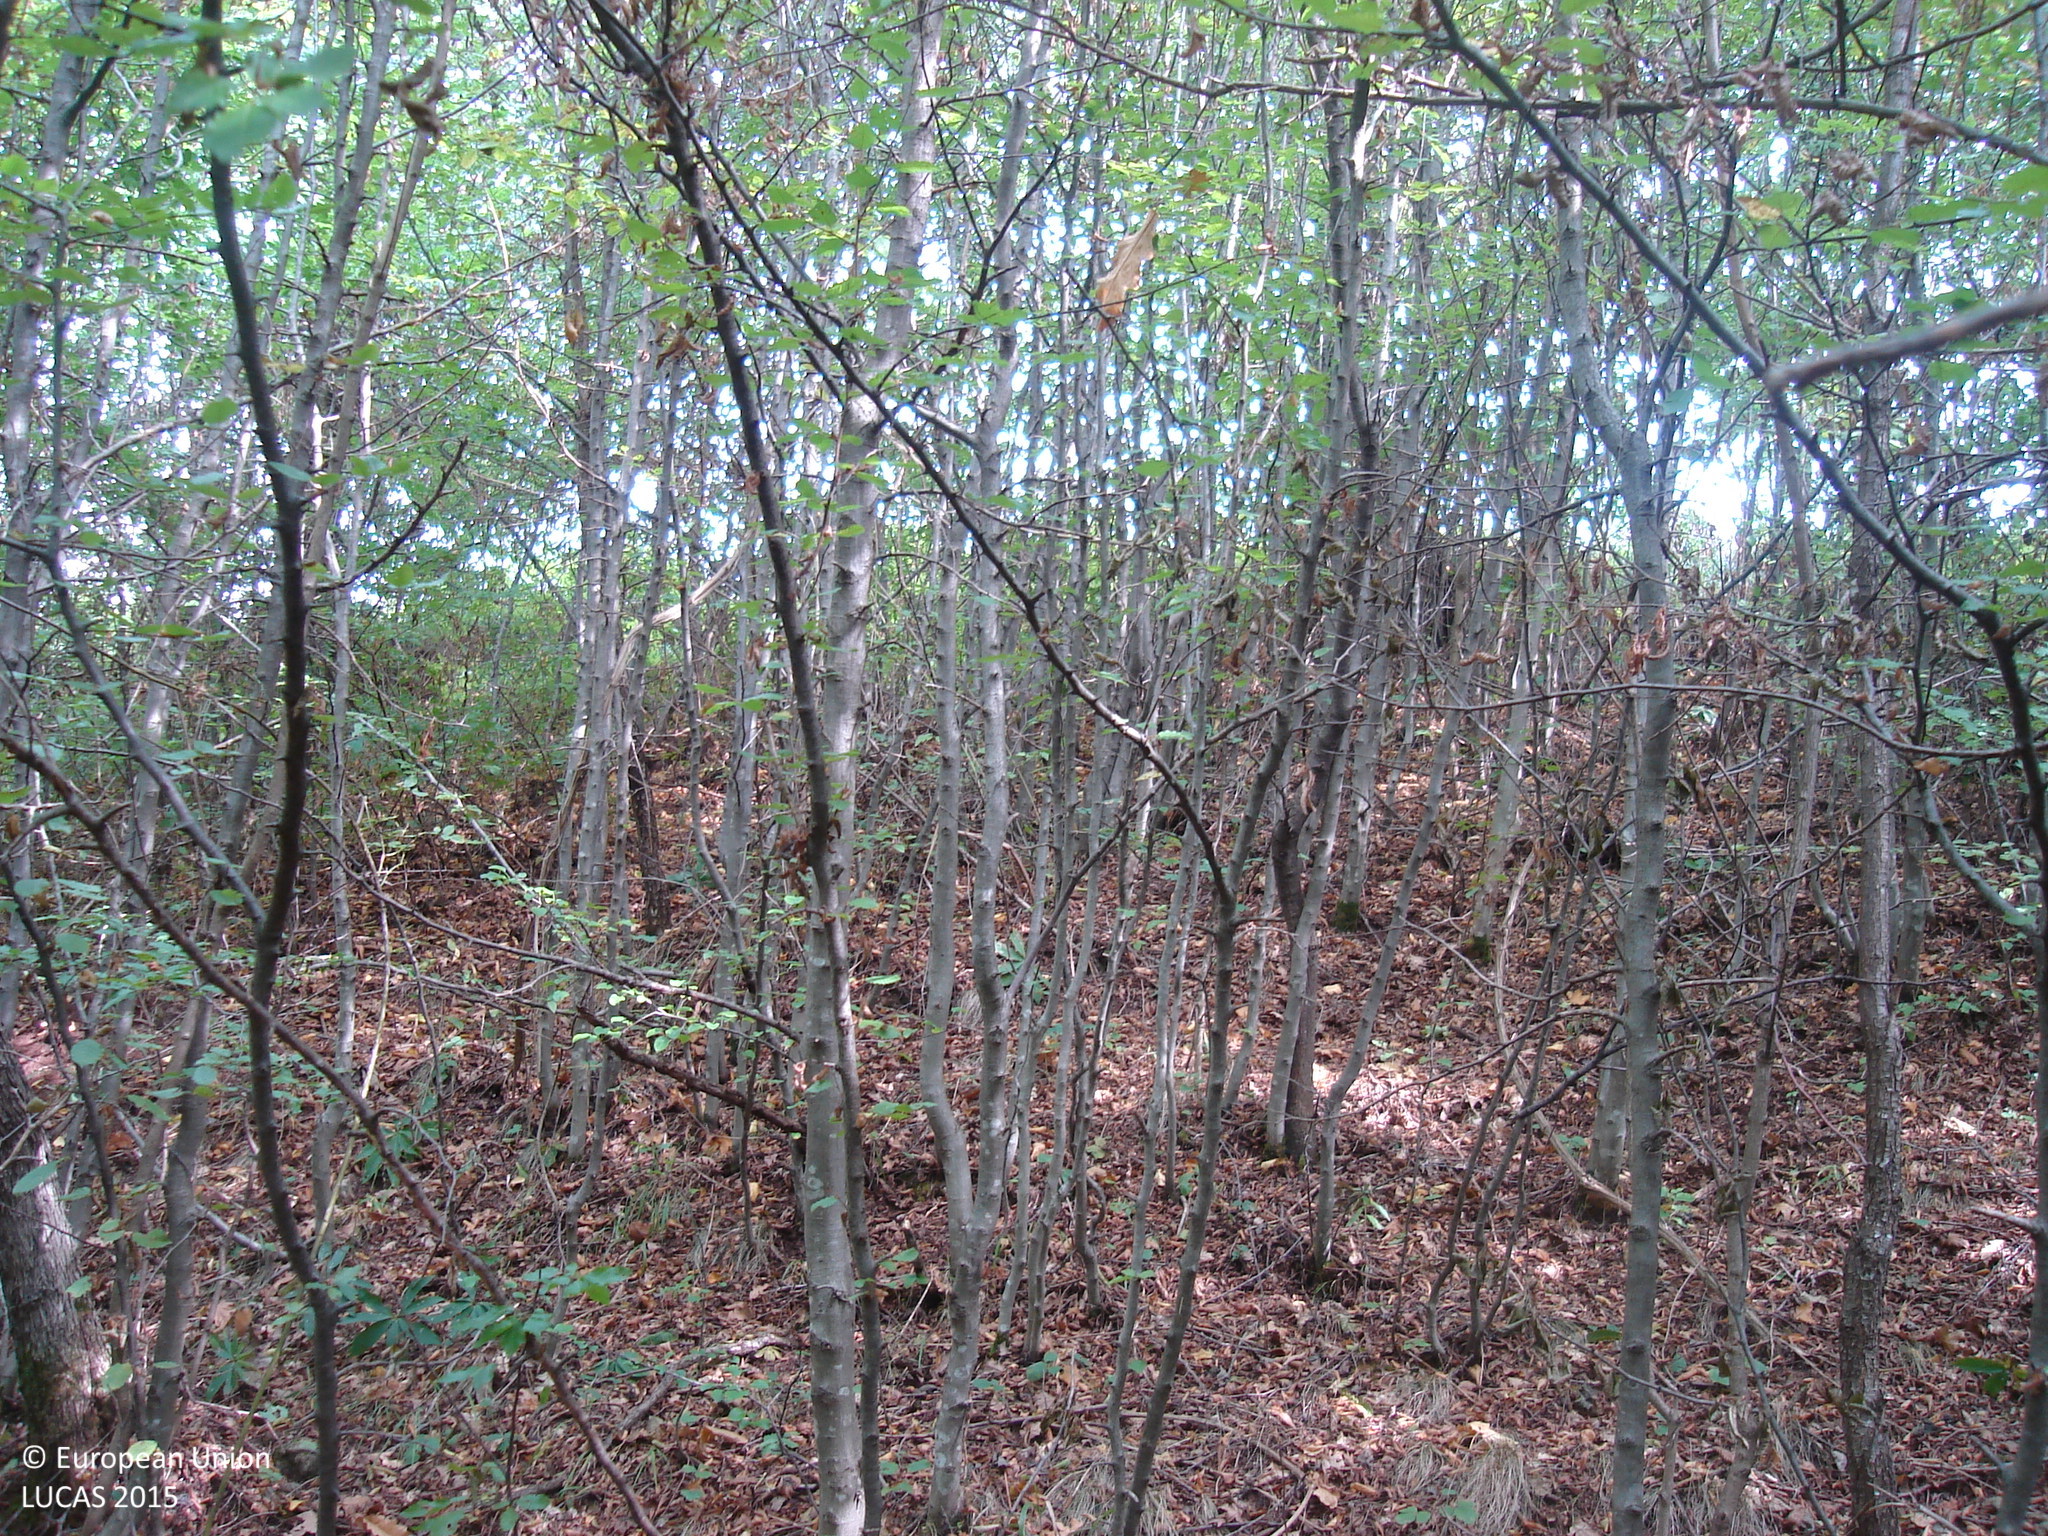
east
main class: Woodland
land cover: Broadleaved woodland
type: mesophytic deciduous forest
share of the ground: > 75 %
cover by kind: broadleaved forest trees 95 %, consolidated bare surface 5 %
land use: Forestry
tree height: < 5 m
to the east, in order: Broadleaved woodland; Grassland without tree/shrub cover; Broadleaved woodland; Grassland without tree/shrub cover; Broadleaved woodland; Grassland without tree/shrub cover; Broadleaved woodland; Grassland without tree/shrub cover; Broadleaved woodland; Tracks; Shrubland with sparse tree cover; Tracks; Broadleaved woodland
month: September
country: BG
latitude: 43.1151
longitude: 23.3734
